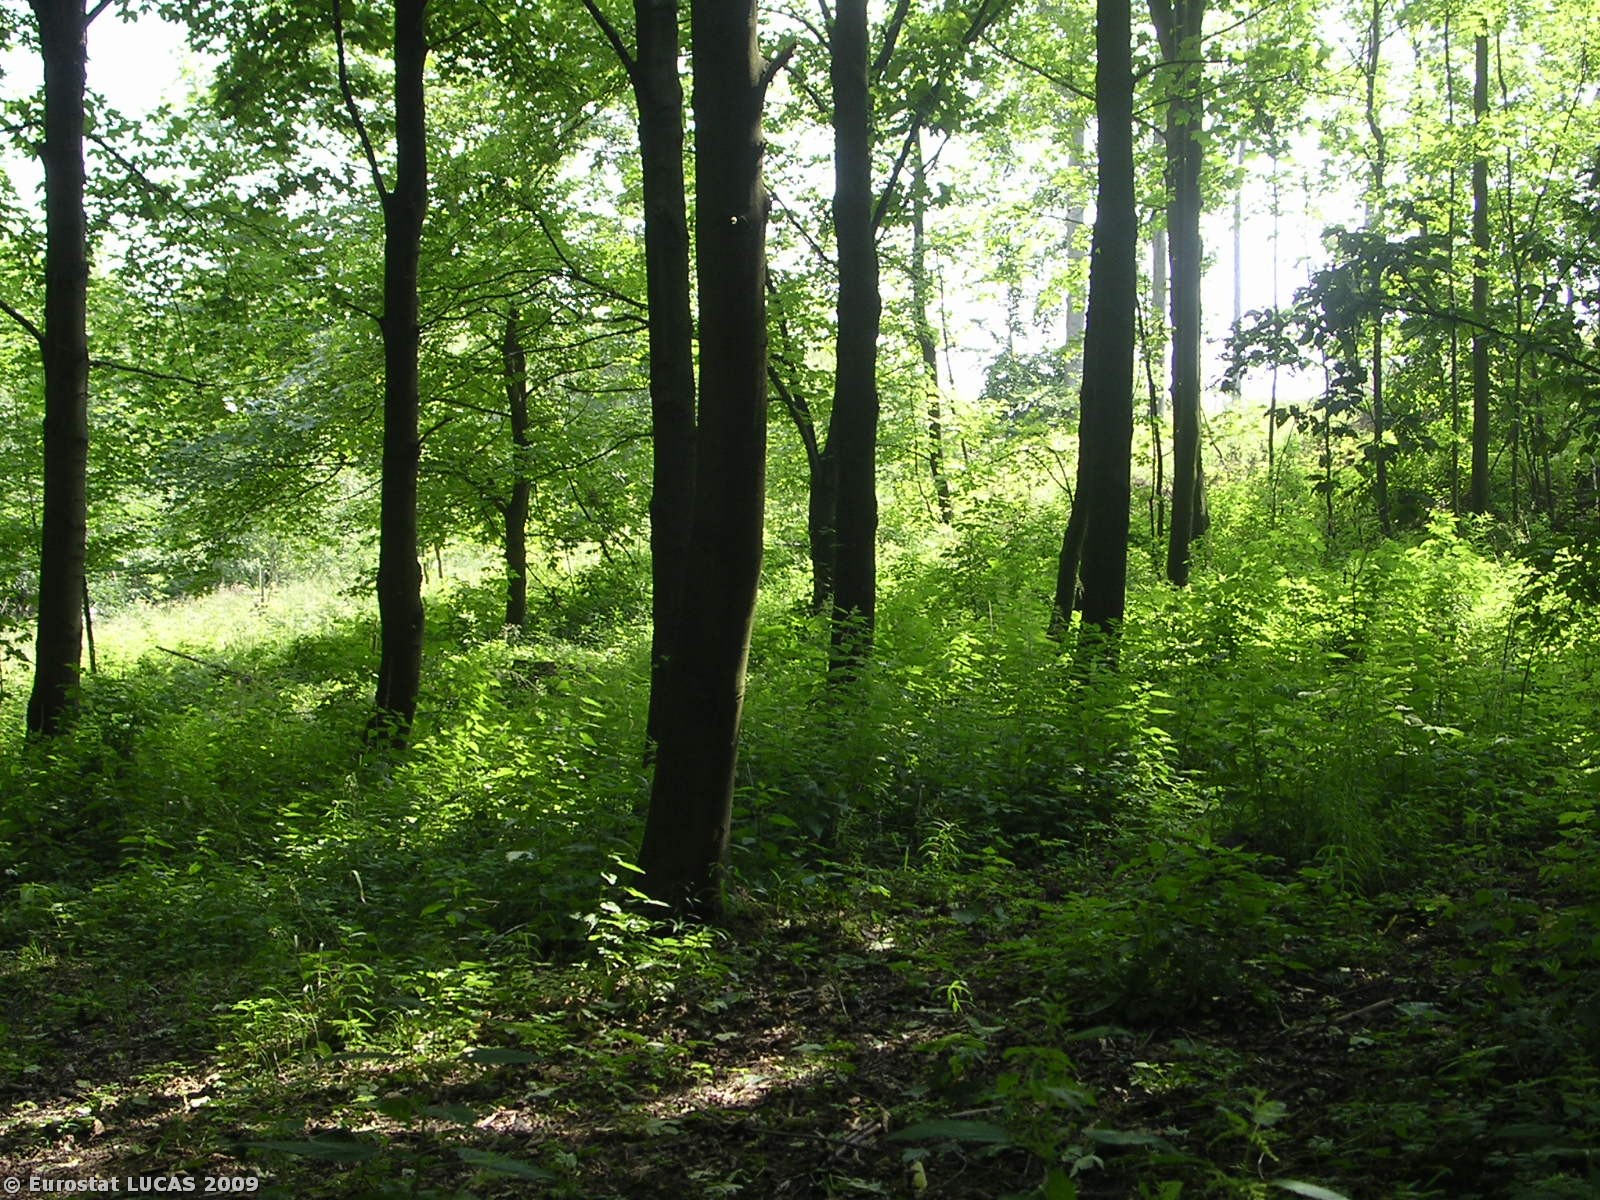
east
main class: Woodland
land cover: Broadleaved woodland
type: mesophytic deciduous forest
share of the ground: > 75 %
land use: Forestry
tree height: > 5 m
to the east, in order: Broadleaved woodland; Grassland with sparse tree/shrub cover; Broadleaved woodland; Mixed woodland; Tracks; Broadleaved woodland; Grassland with sparse tree/shrub cover
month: June
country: CZ
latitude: 50.6798
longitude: 14.2896
